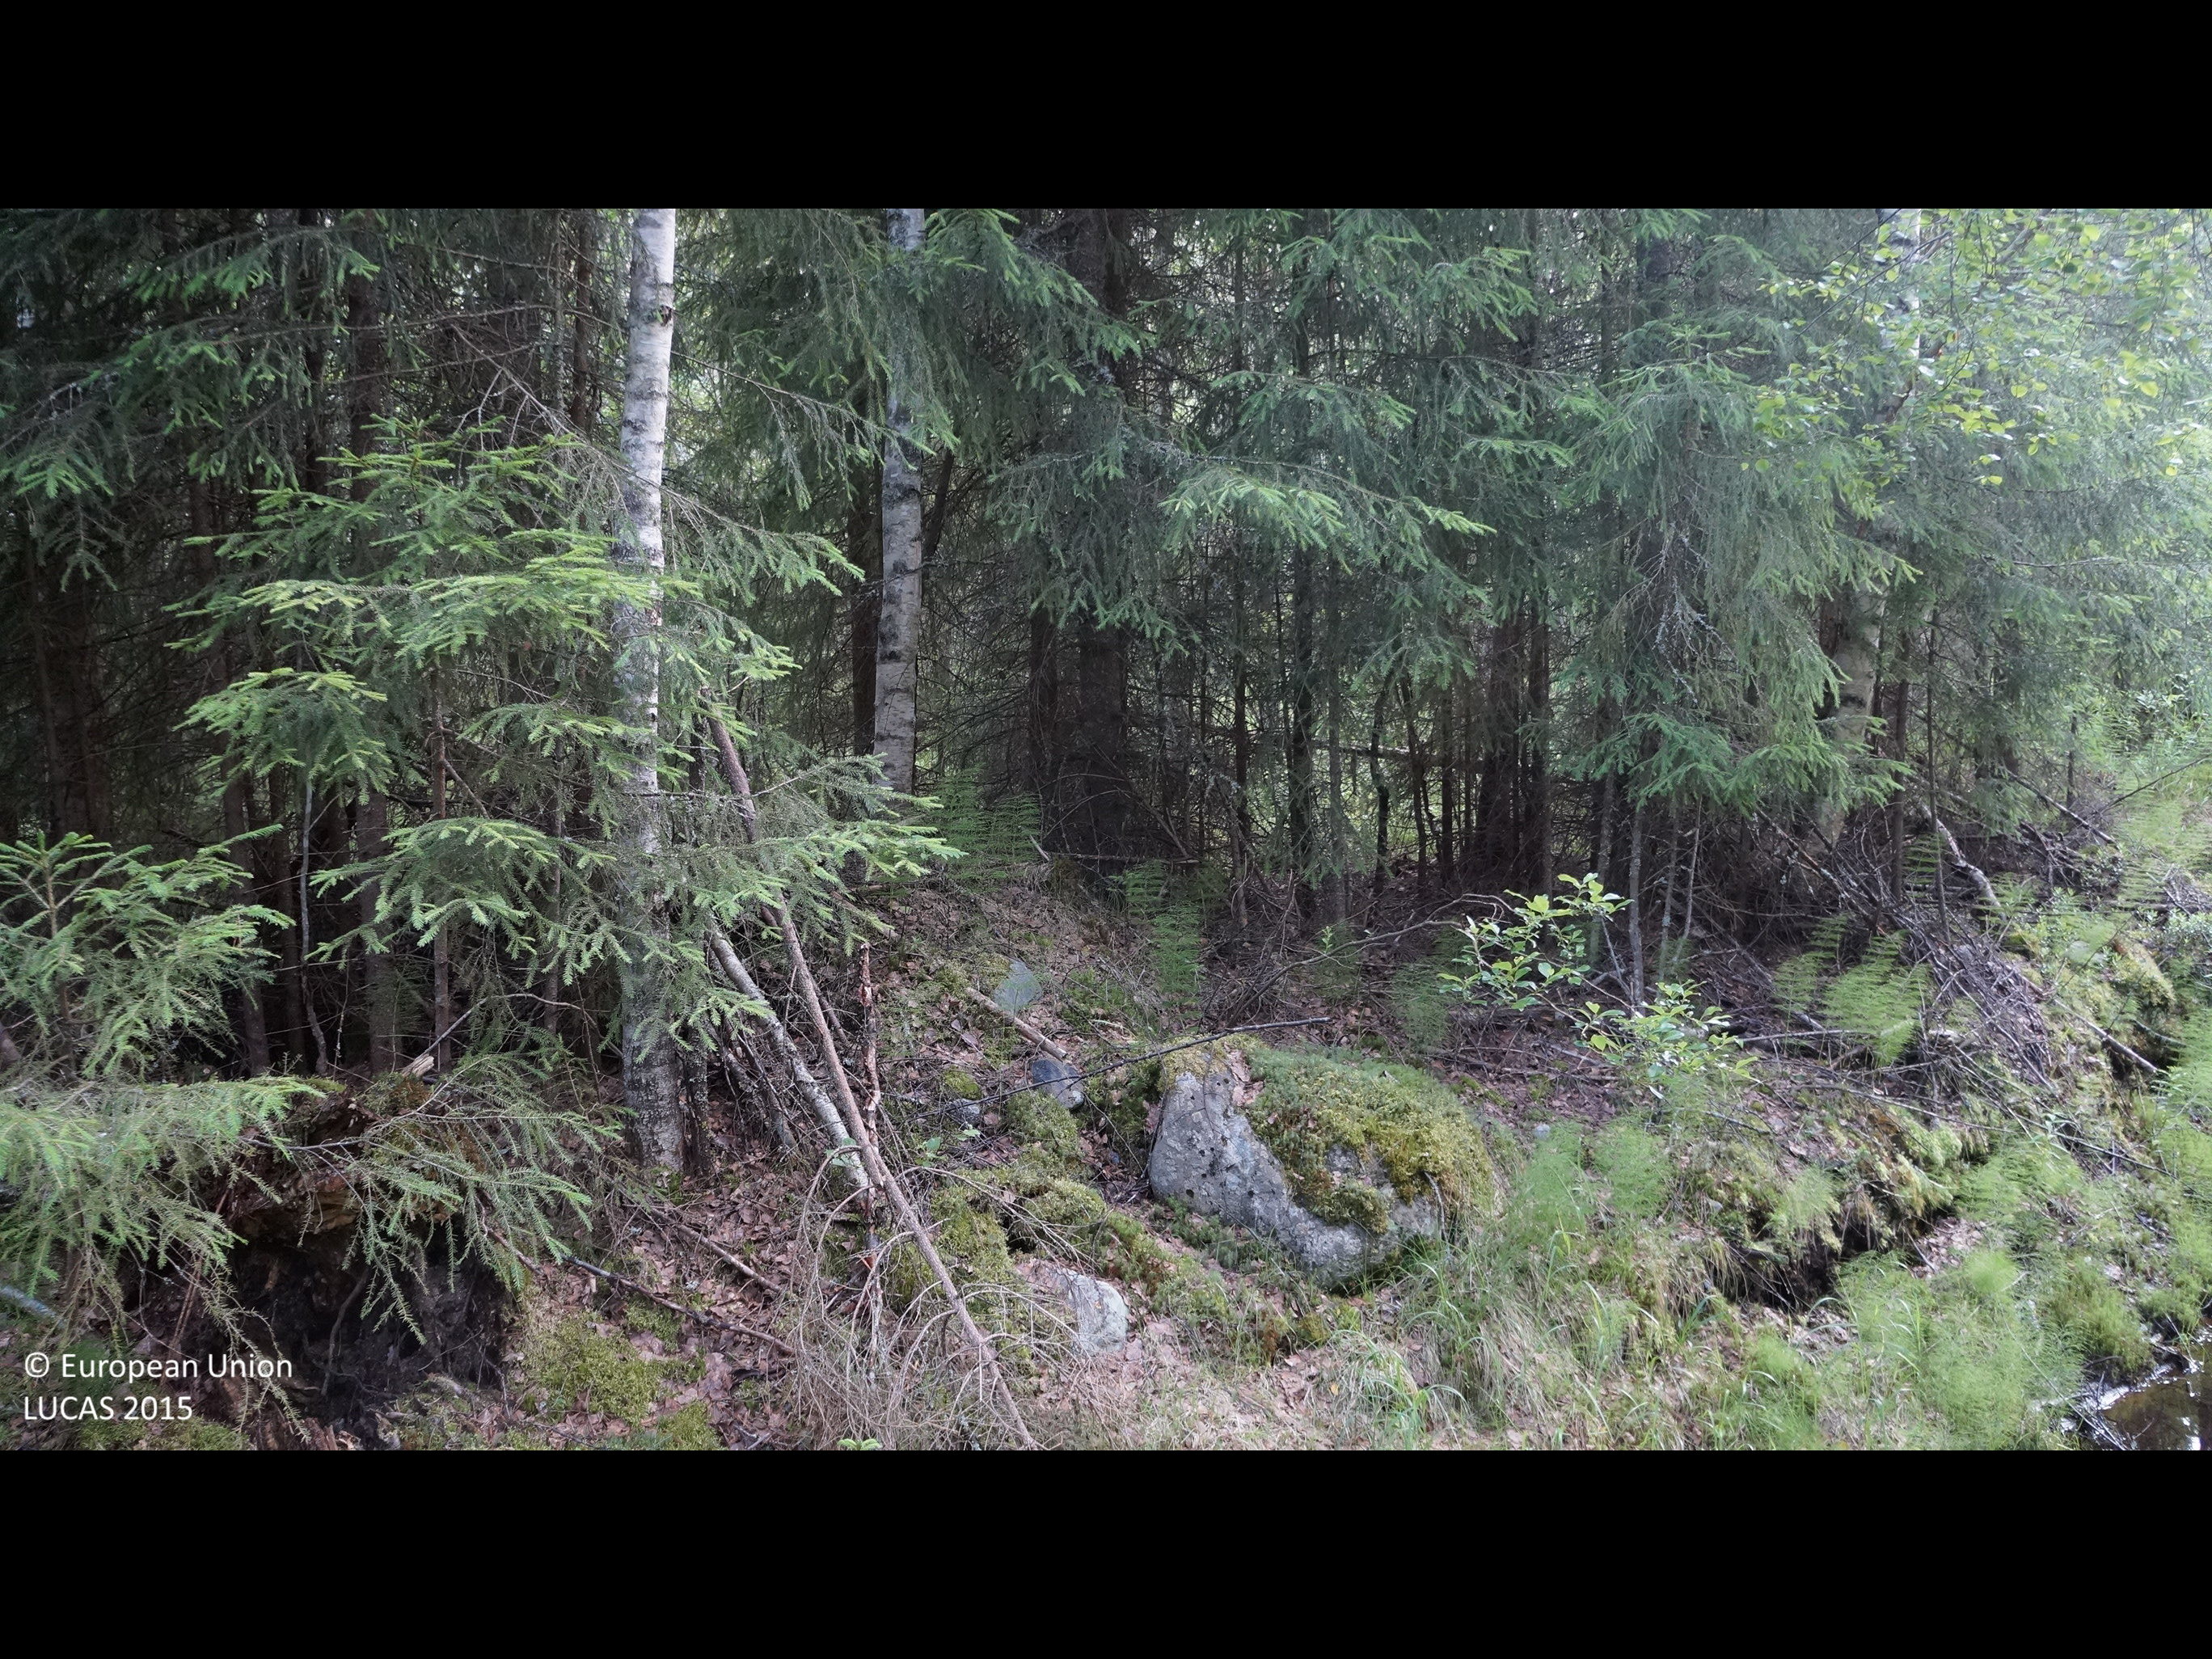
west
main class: Woodland
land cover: Other mixed woodland
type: boreal forest
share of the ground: 50 - 75 %
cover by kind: coniferous forest trees 35 %, shrubs 30 %, broadleaved forest trees 15 %, lichens and mosses 10 %, herbaceous plants 5 %, consolidated bare surface 5 %
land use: Forestry
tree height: > 5 m
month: July
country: FI
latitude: 63.7382
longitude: 23.9841
